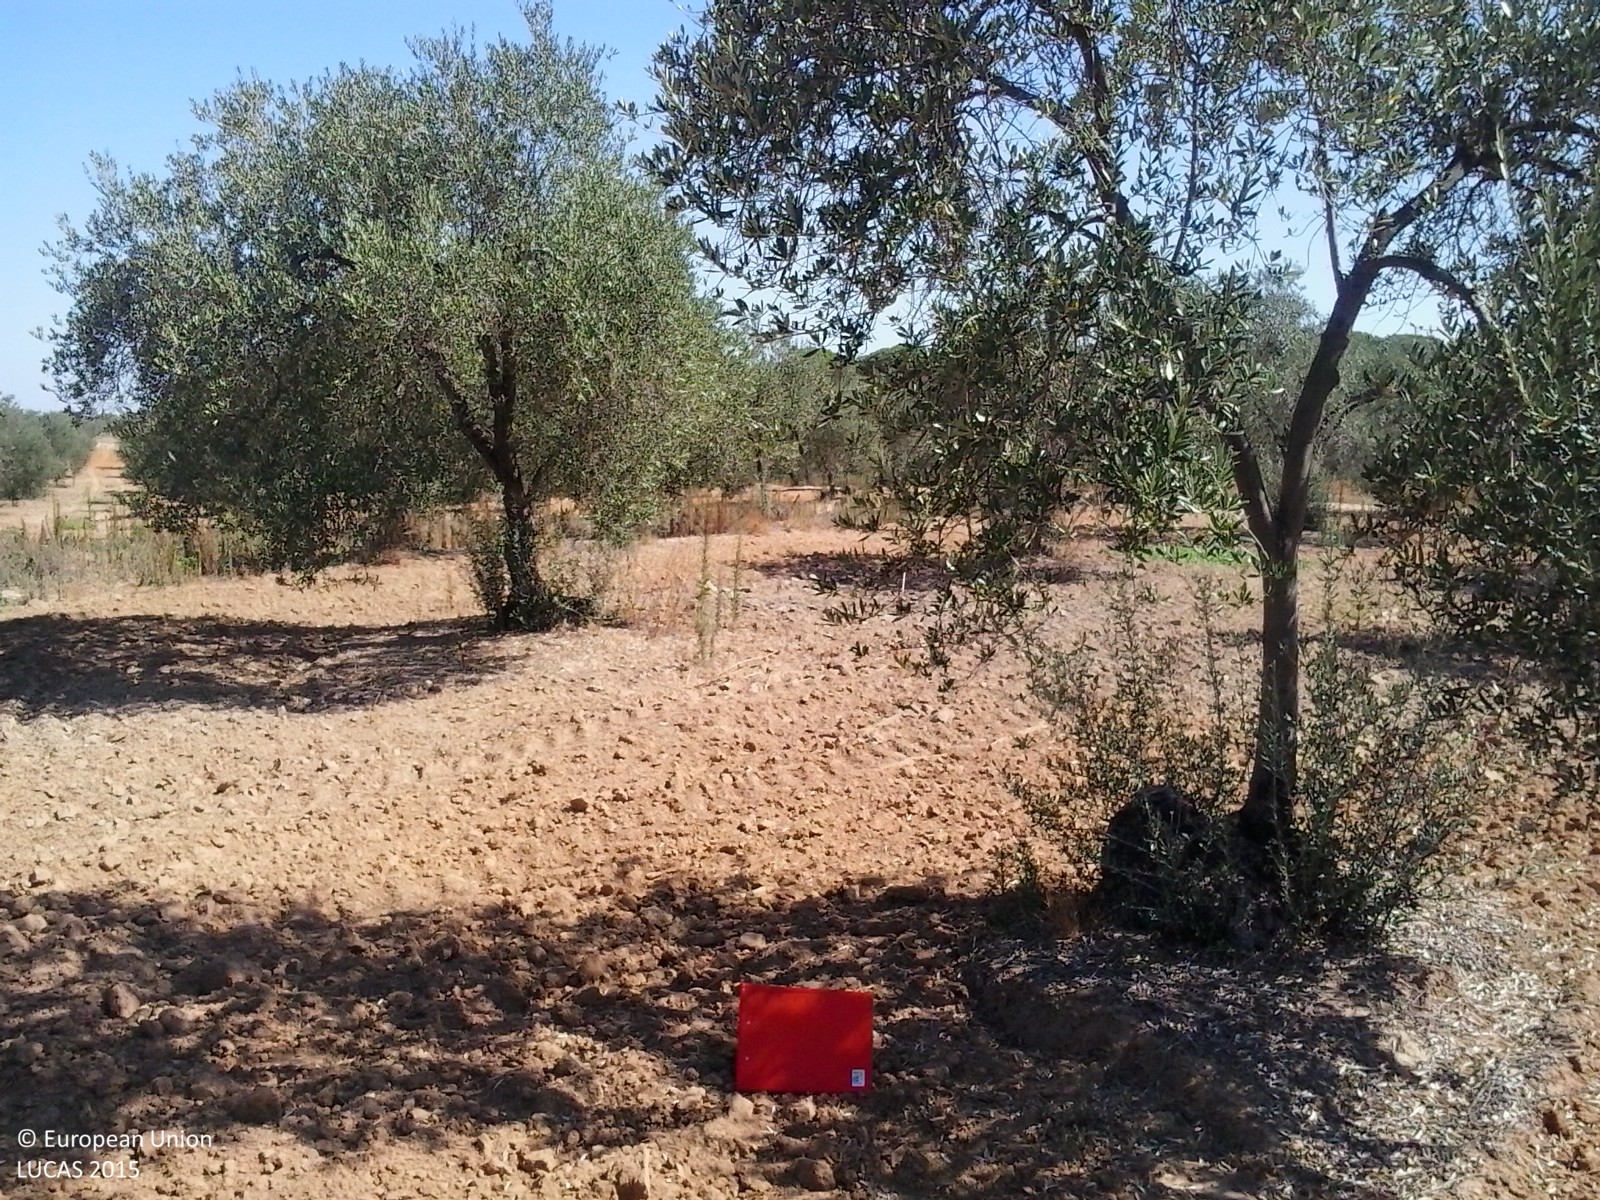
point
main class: Cropland
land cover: Olive groves
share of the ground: 10 - 25 %
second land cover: Other bare soil
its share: > 75 %
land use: Agriculture (excluding fallow land and kitchen gardens)
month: July
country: ES
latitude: 37.2604
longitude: -6.3659
